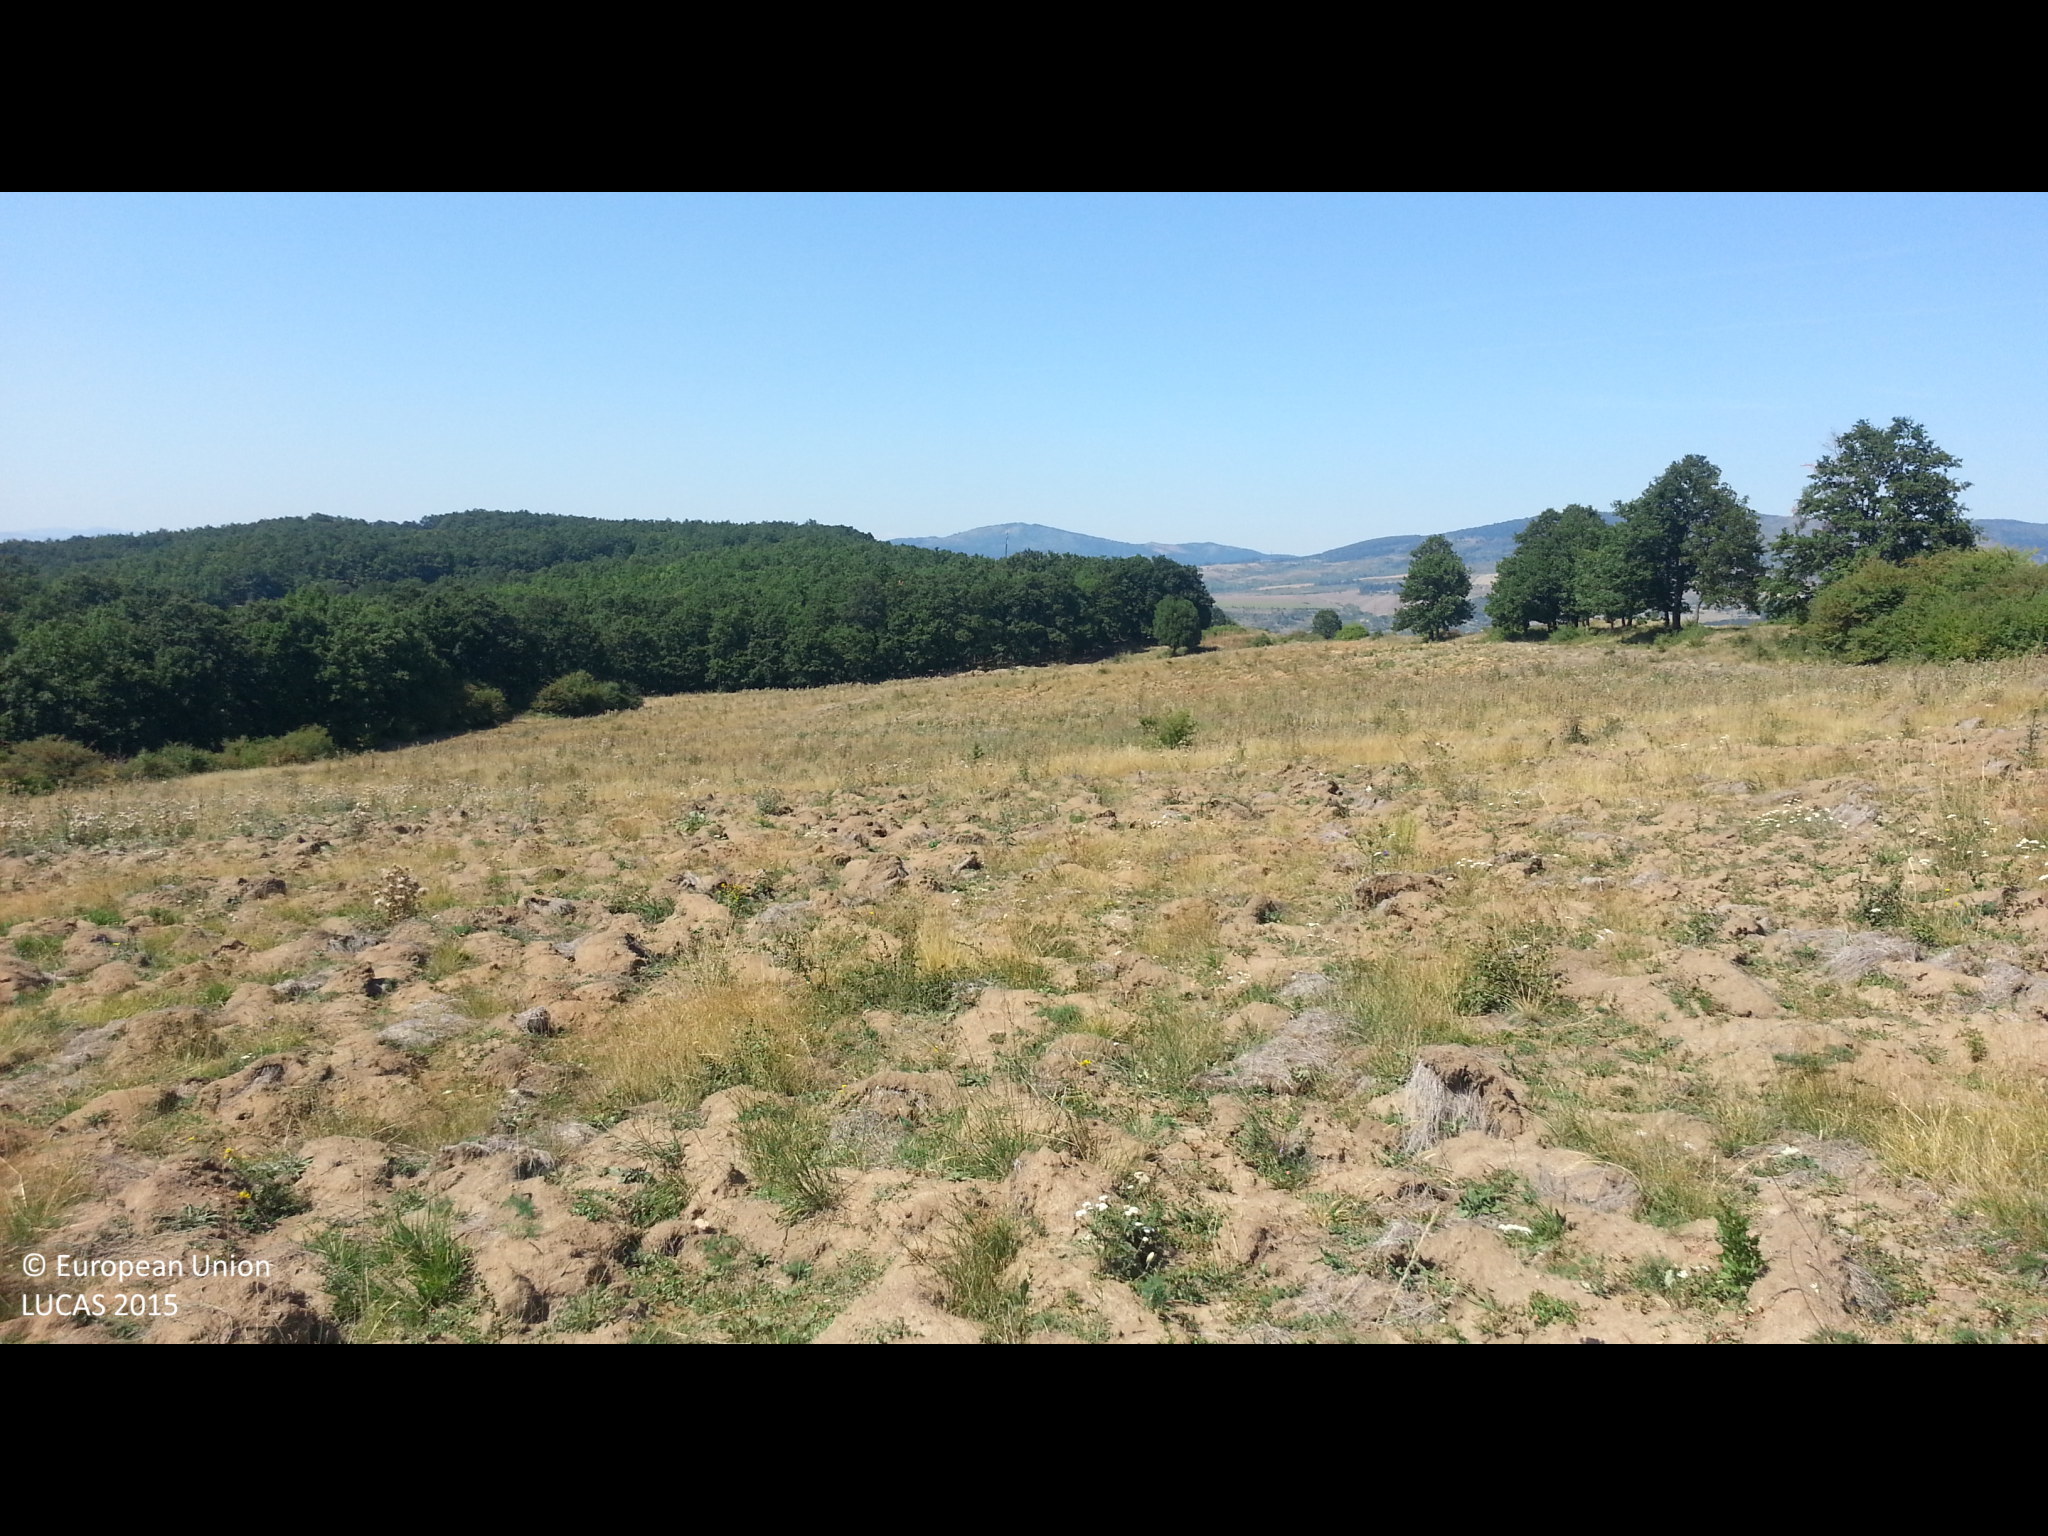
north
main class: Grassland
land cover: Spontaneously vegetated surfaces
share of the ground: 50 - 75 %
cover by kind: herbaceous plants 70 %, unconsolidated bare surface 30 %
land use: Fallow land
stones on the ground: < 10 %
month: August
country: BG
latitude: 42.5779
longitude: 23.1525
